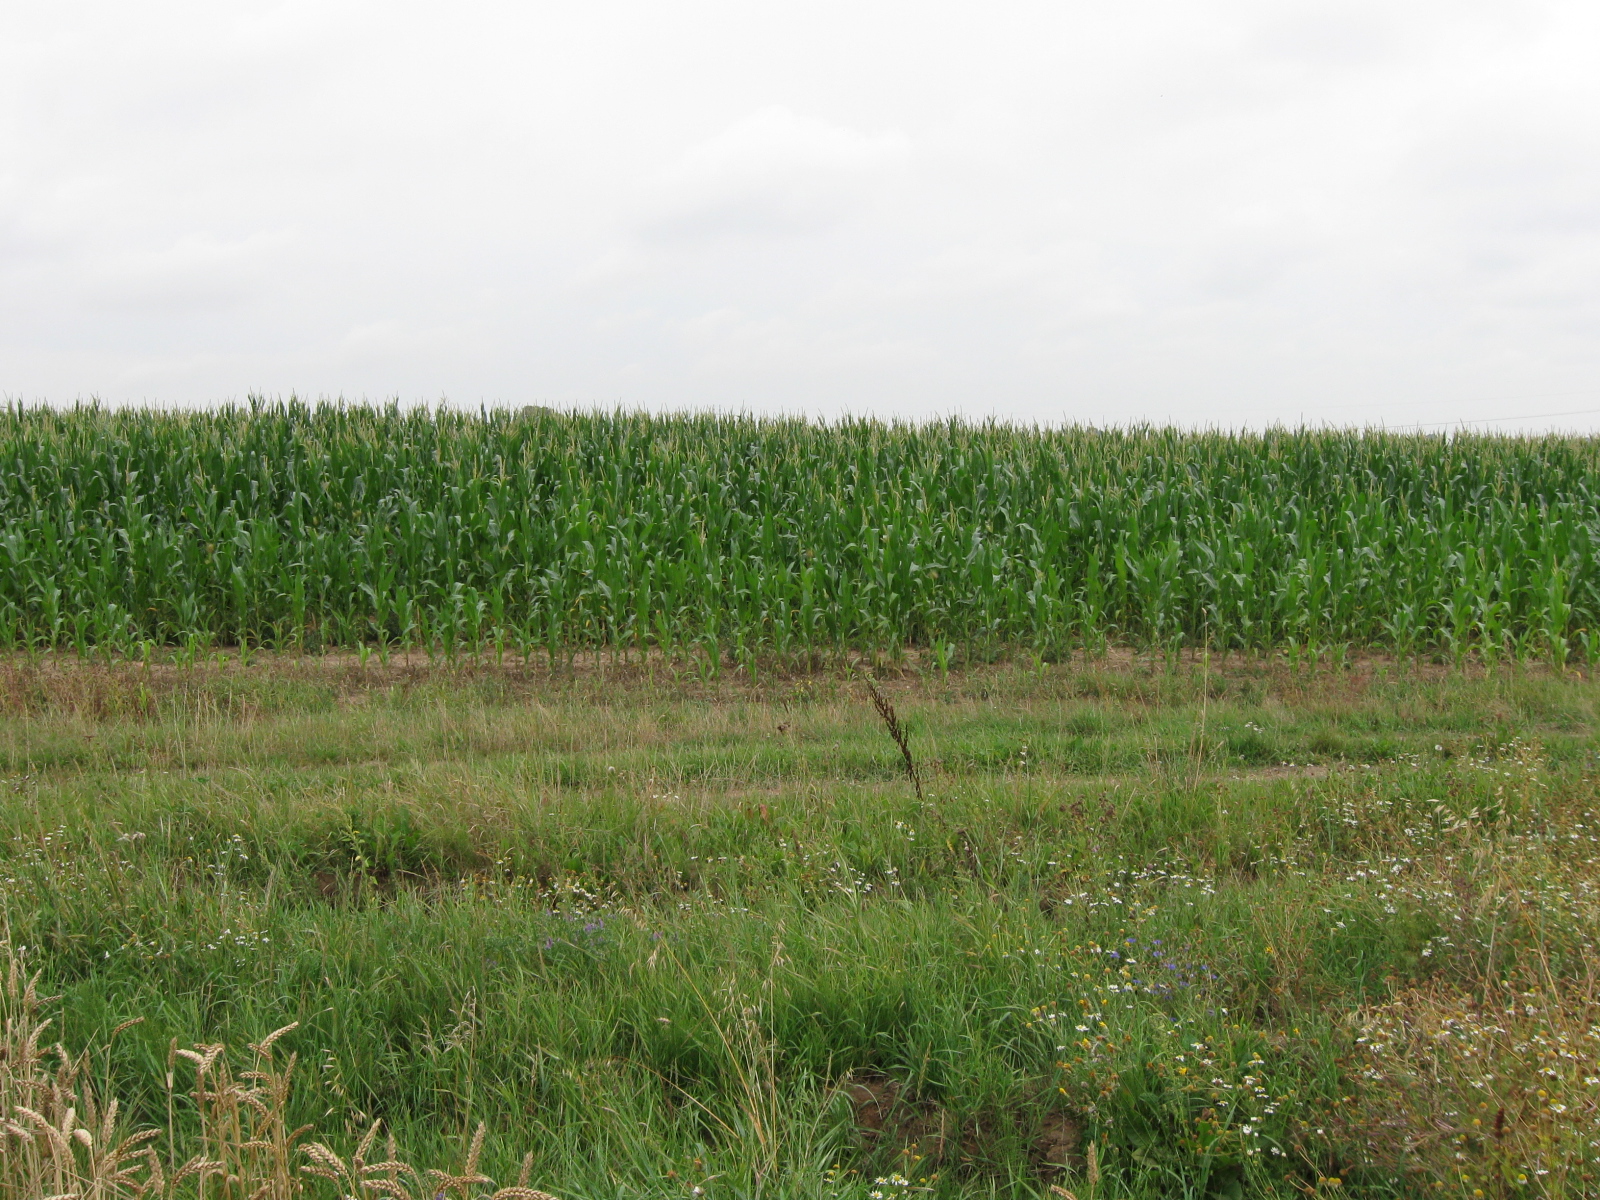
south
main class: Cropland
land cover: Common wheat
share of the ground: > 75 %
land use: Agriculture (excluding fallow land and kitchen gardens)
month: August
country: LT
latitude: 54.6113
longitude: 23.5060
